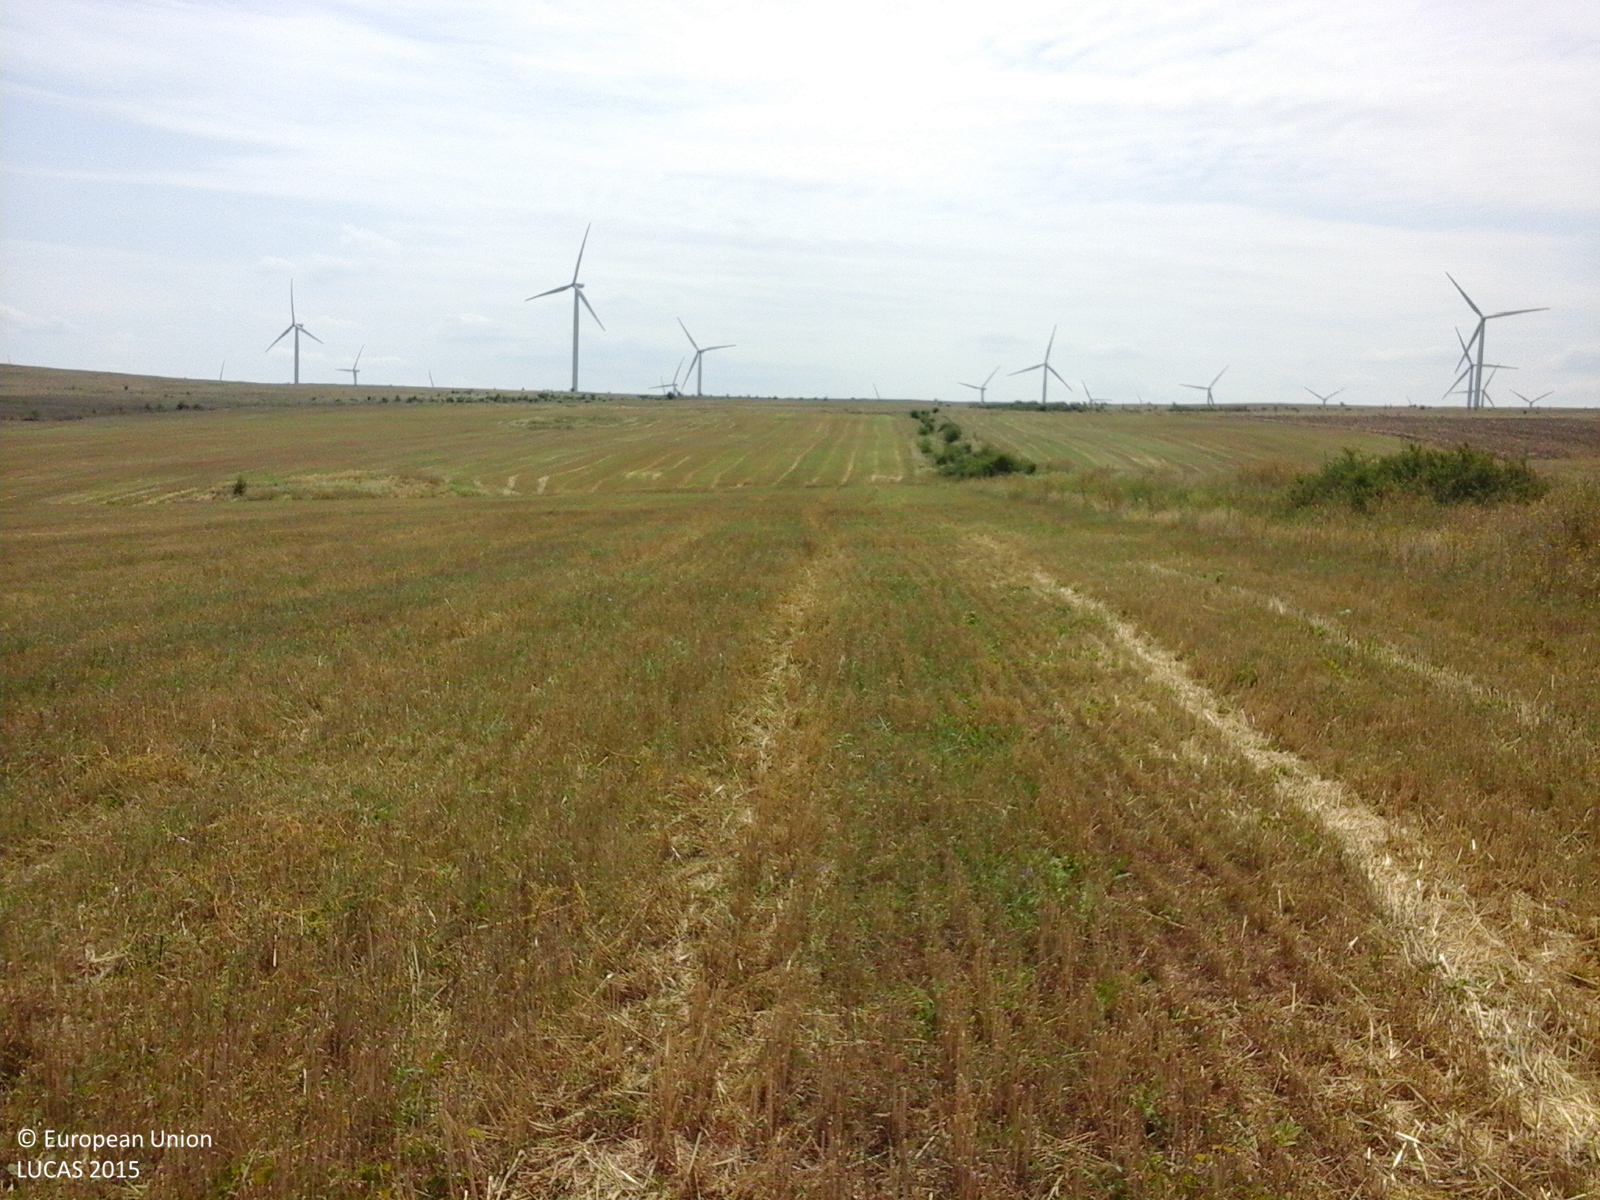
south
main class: Cropland
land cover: Common wheat
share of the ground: > 75 %
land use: Agriculture (excluding fallow land and kitchen gardens)
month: August
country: RO
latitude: 44.6718
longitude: 28.5564
